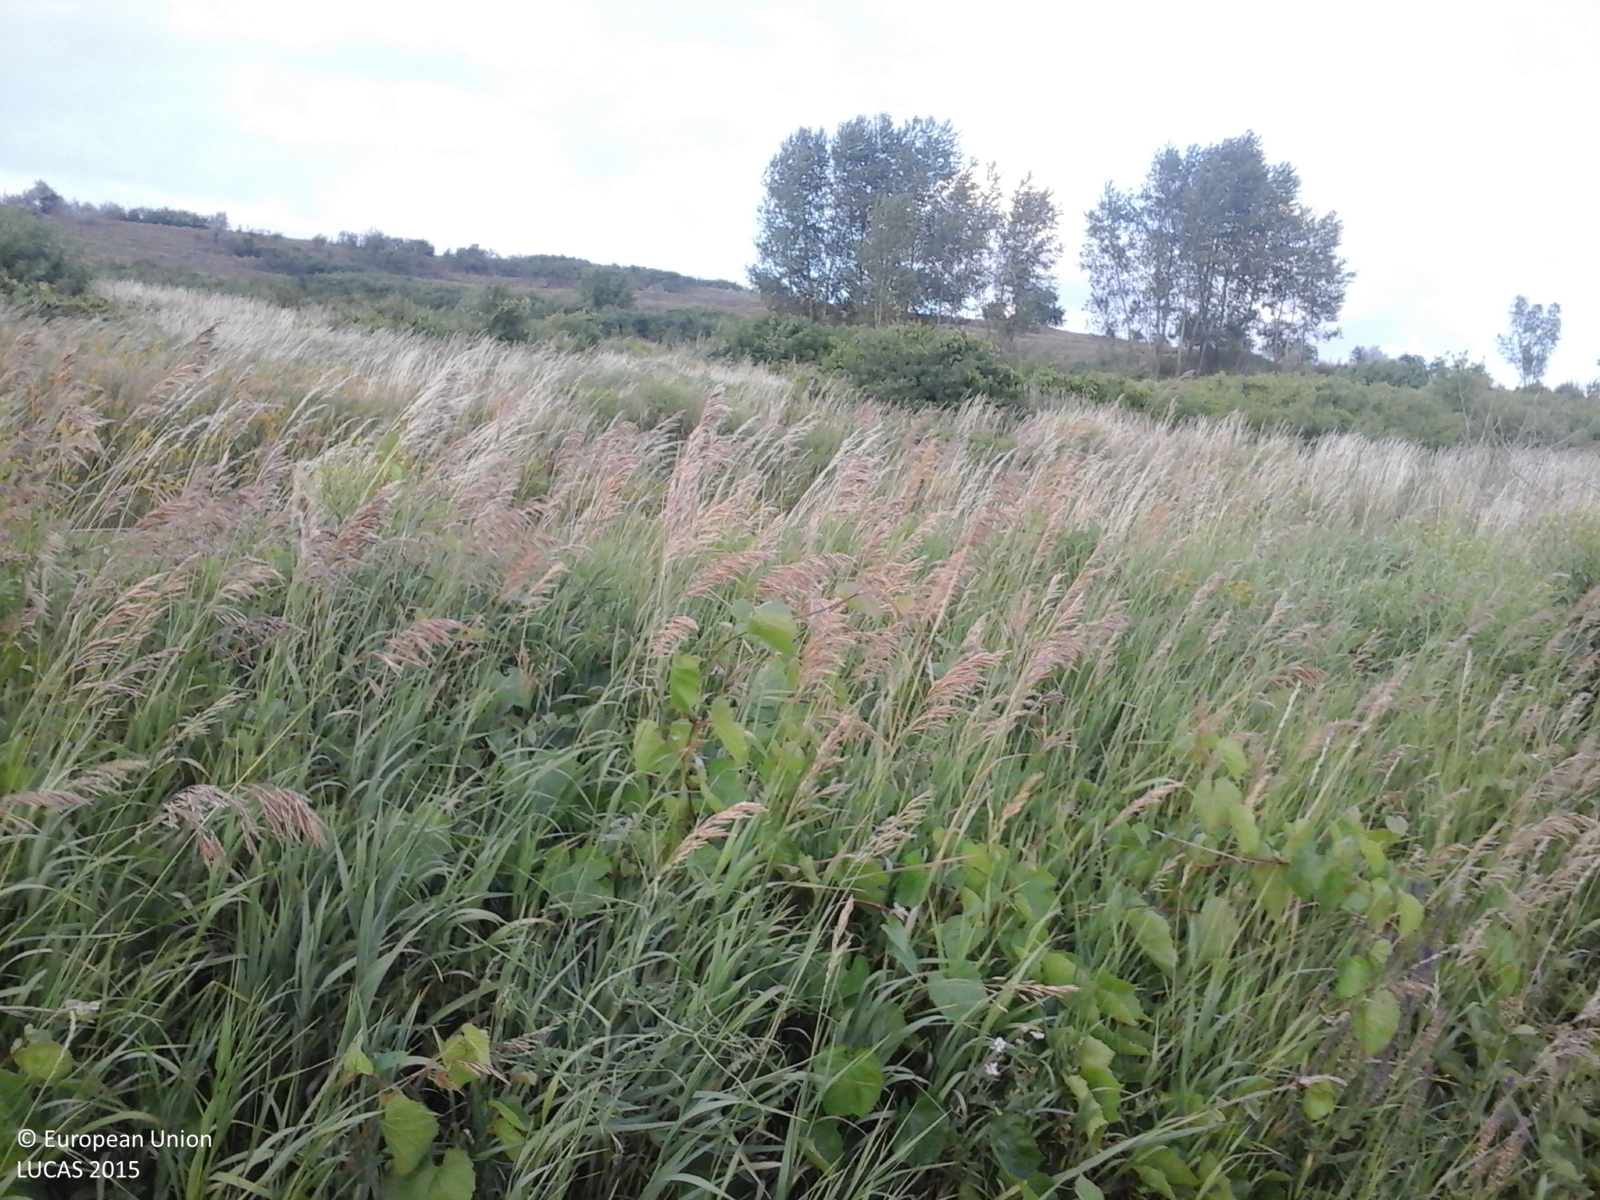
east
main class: Cropland
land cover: Lucerne
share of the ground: > 75 %
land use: Agriculture (excluding fallow land and kitchen gardens)
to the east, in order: Lucerne; Spontaneously vegetated surfaces; Lucerne; Spontaneously vegetated surfaces; Lucerne; Vineyards; Grassland with sparse tree/shrub cover; Vineyards; Shrubland with sparse tree cover; Vineyards; Grassland with sparse tree/shrub cover; Grassland without tree/shrub cover; Shrubland with sparse tree cover
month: June
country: RO
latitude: 46.6657
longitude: 27.6972
